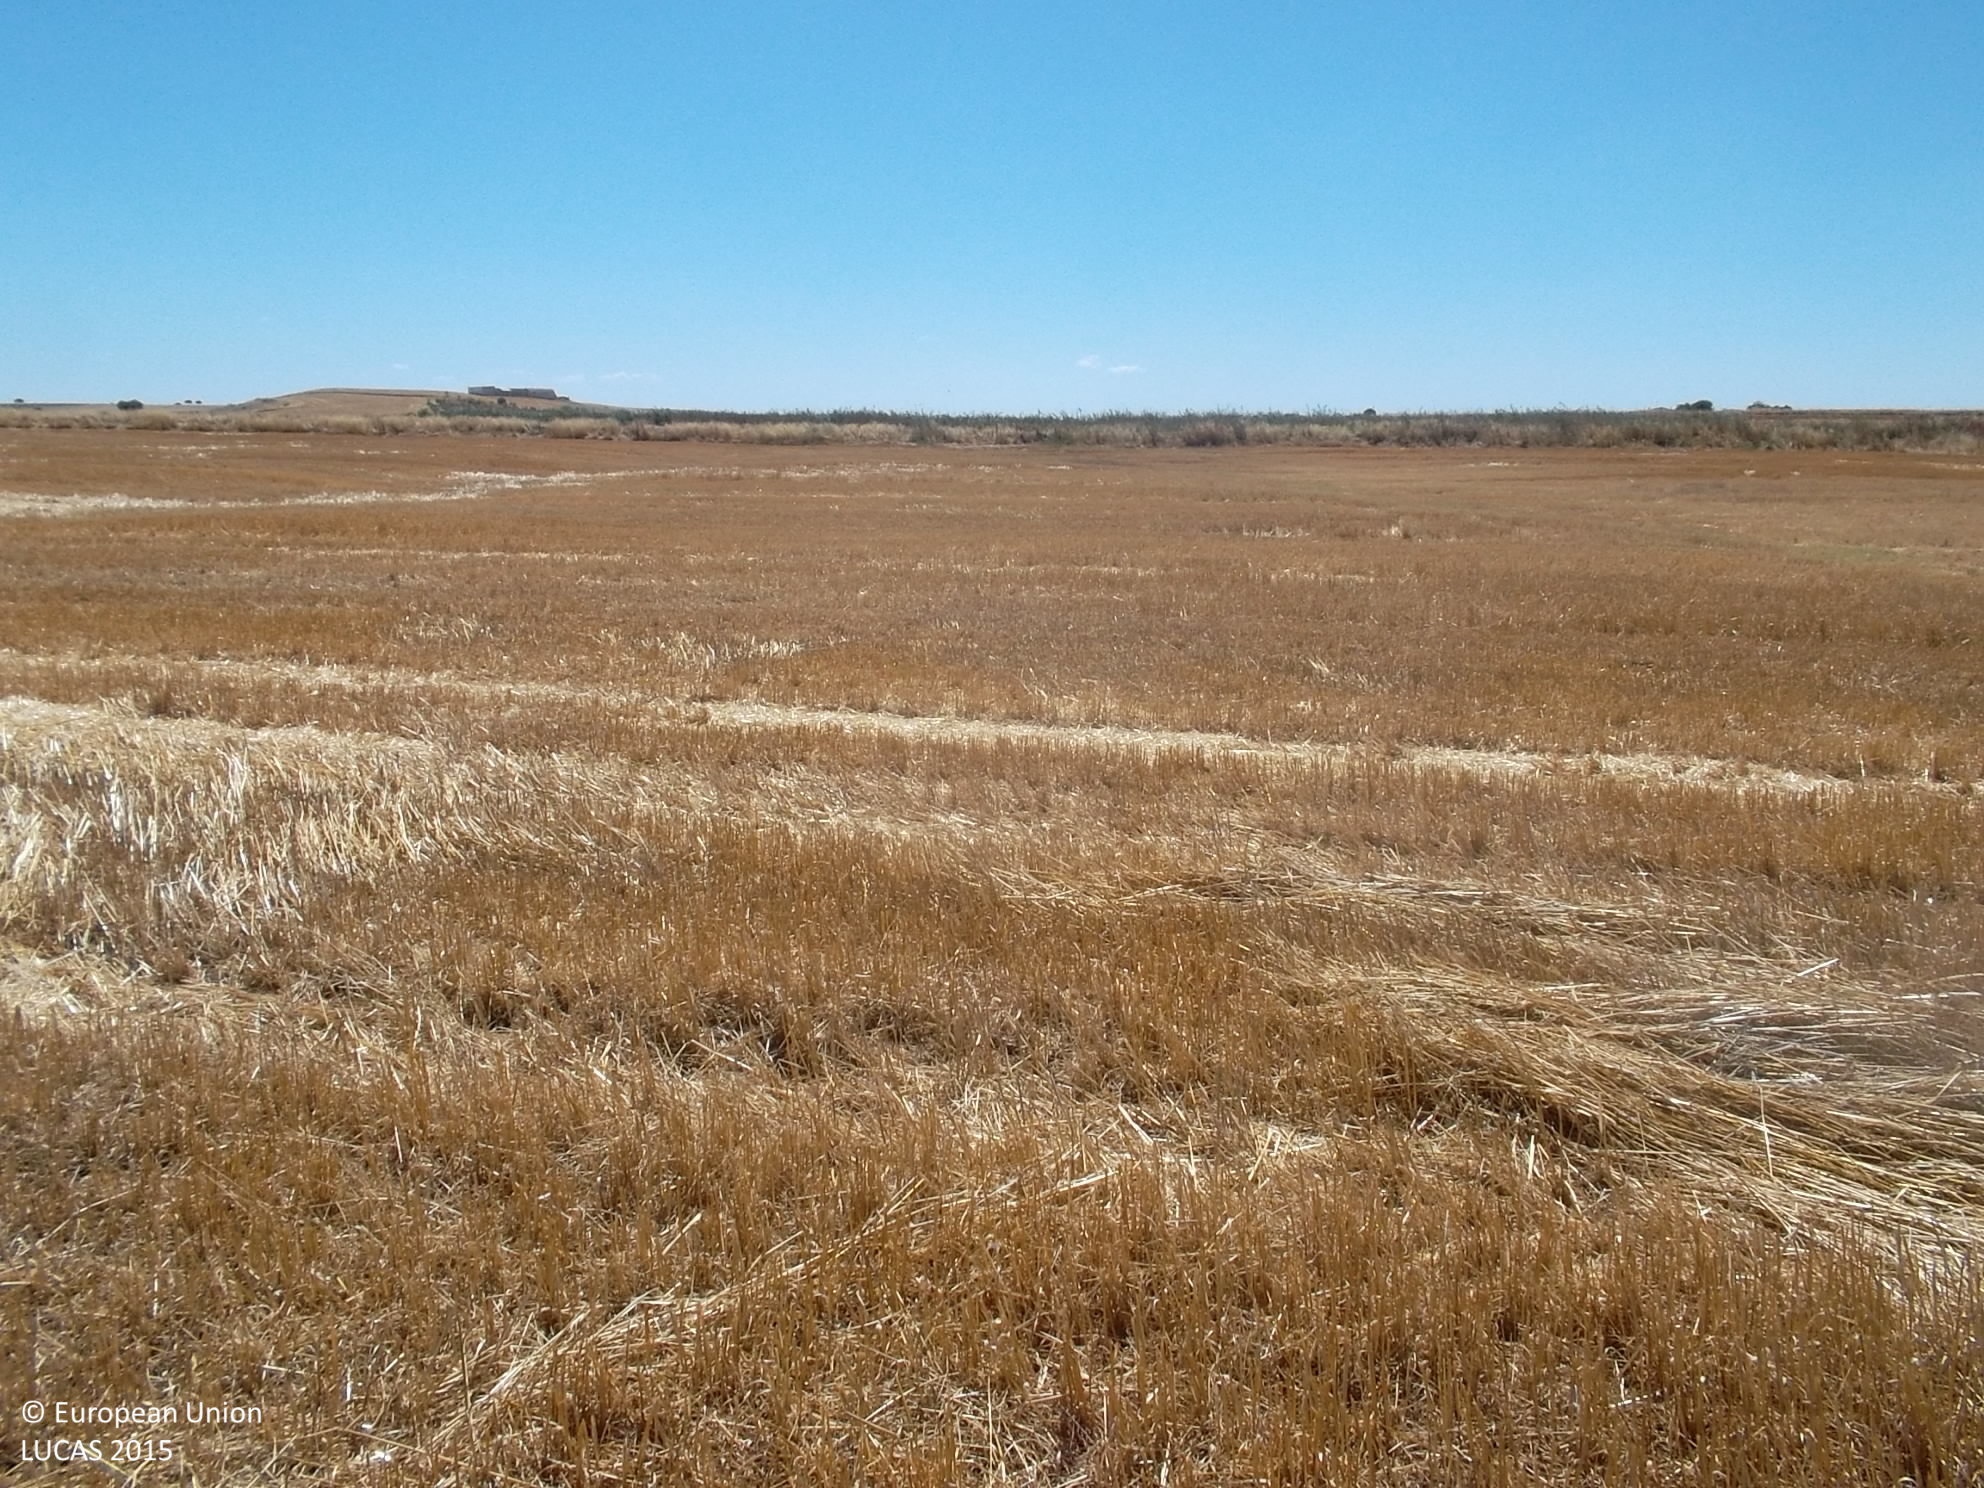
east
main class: Cropland
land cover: Barley
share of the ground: < 10 %
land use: Agriculture (excluding fallow land and kitchen gardens)
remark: Harvested field
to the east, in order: Barley; Shruby margins; Arable land (only in case pi)
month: July
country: ES
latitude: 38.4173
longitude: -5.7405
